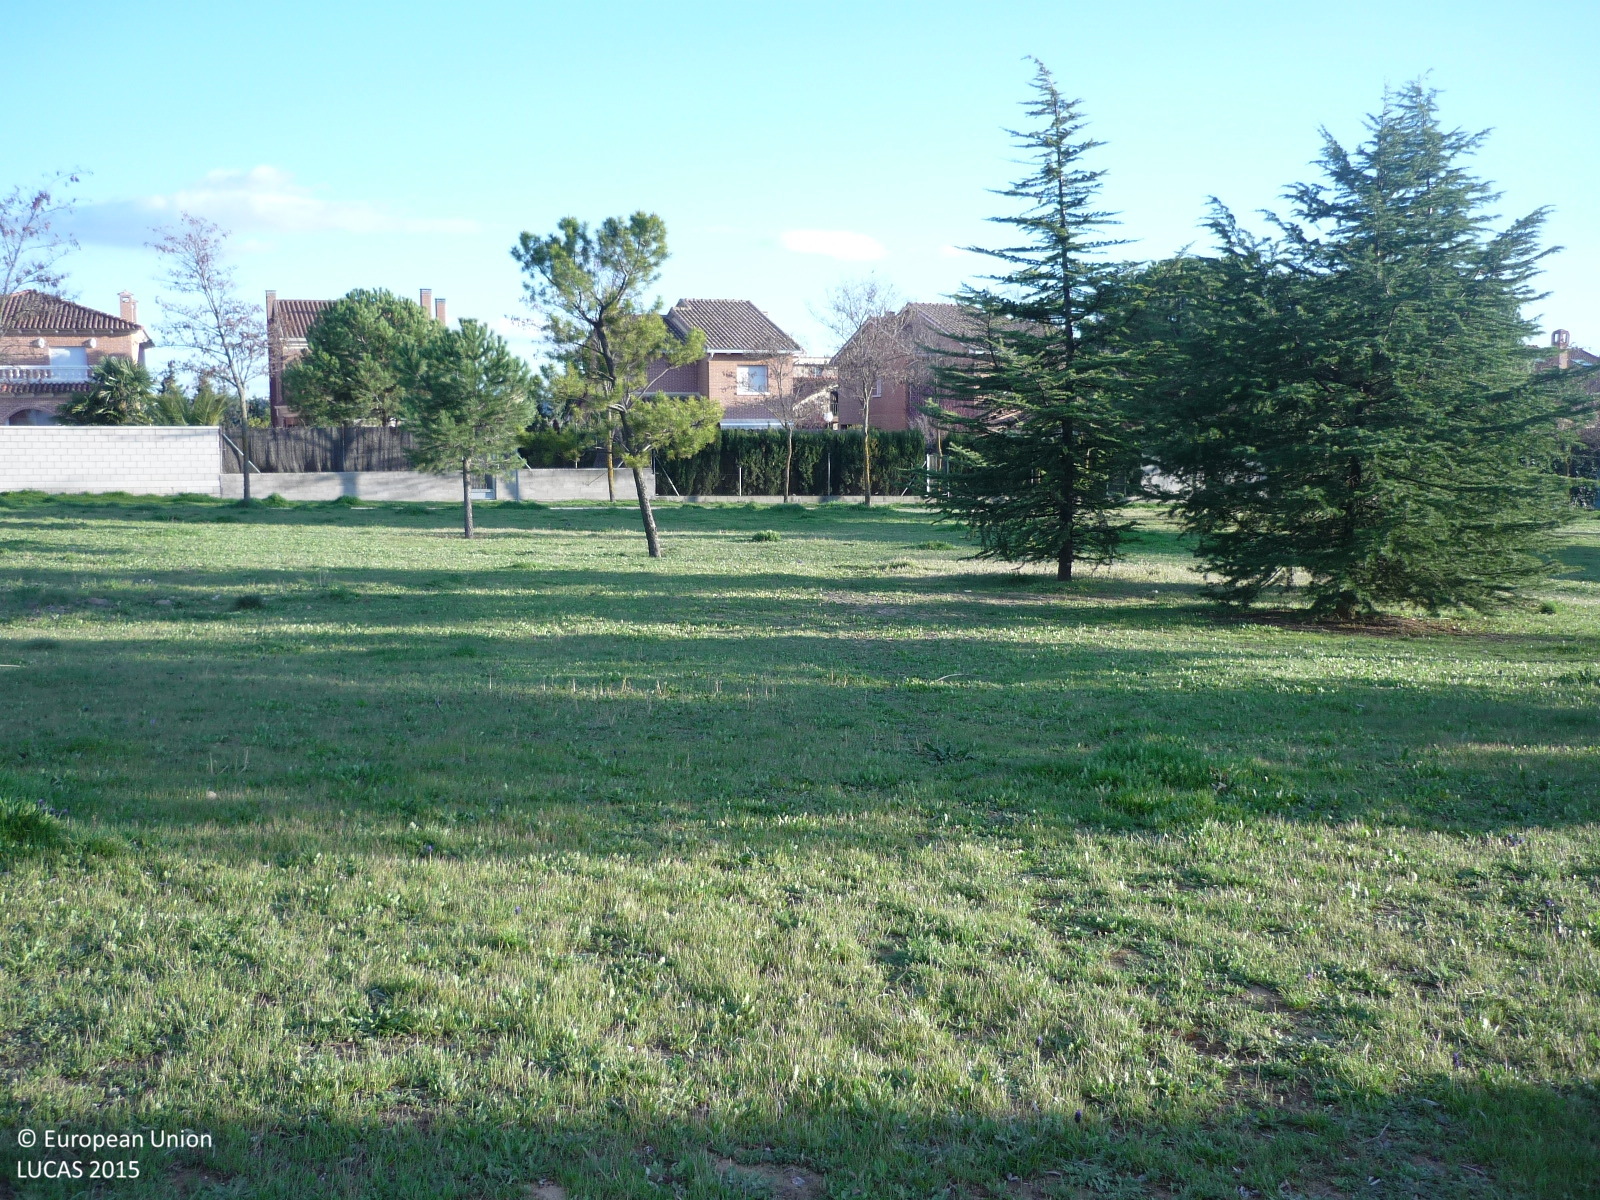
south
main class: Woodland
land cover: Other mixed woodland
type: coniferous forest of the mediterranean region
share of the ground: 25 - 50 %
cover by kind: herbaceous plants 70 %, coniferous forest trees 20 %, broadleaved forest trees 10 %
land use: Residential
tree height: < 5 m
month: March
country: ES
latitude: 40.4464
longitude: -3.3685
